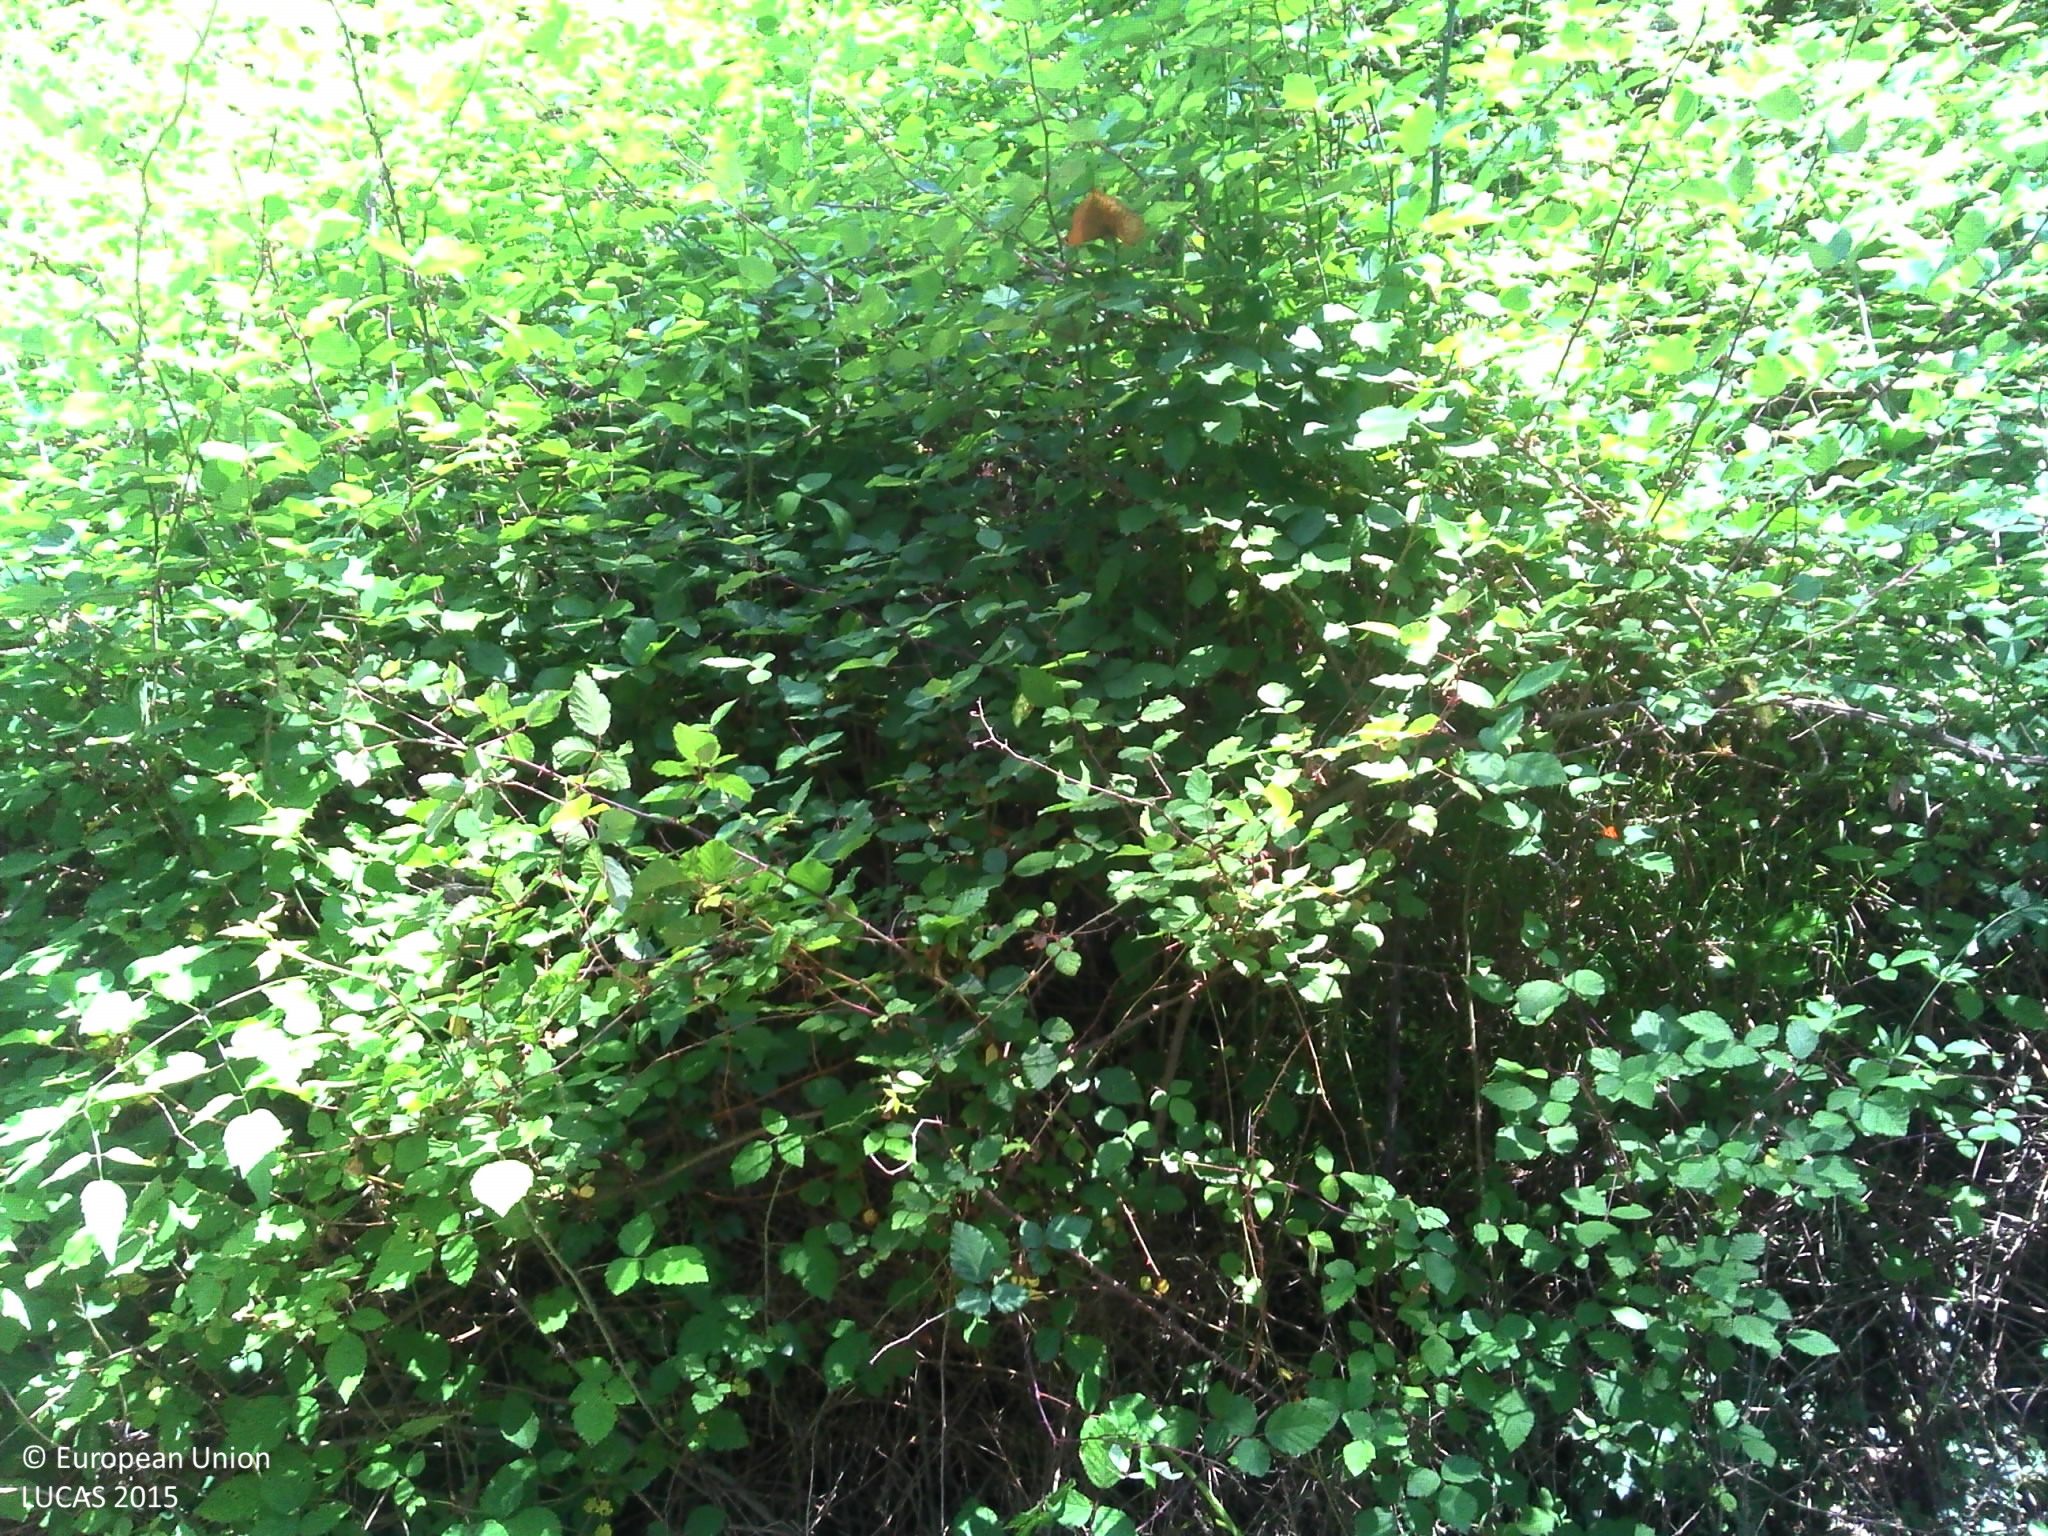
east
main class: Woodland
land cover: Broadleaved woodland
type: broadleaved evergreen forest
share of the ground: > 75 %
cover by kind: broadleaved forest trees 80 %, shrubs 20 %
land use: Forestry
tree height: > 5 m
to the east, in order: Broadleaved woodland; Tracks; Broadleaved woodland; Grassland without tree/shrub cover; Shrubland without tree cover
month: June
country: FR
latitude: 42.5973
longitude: 9.2834
